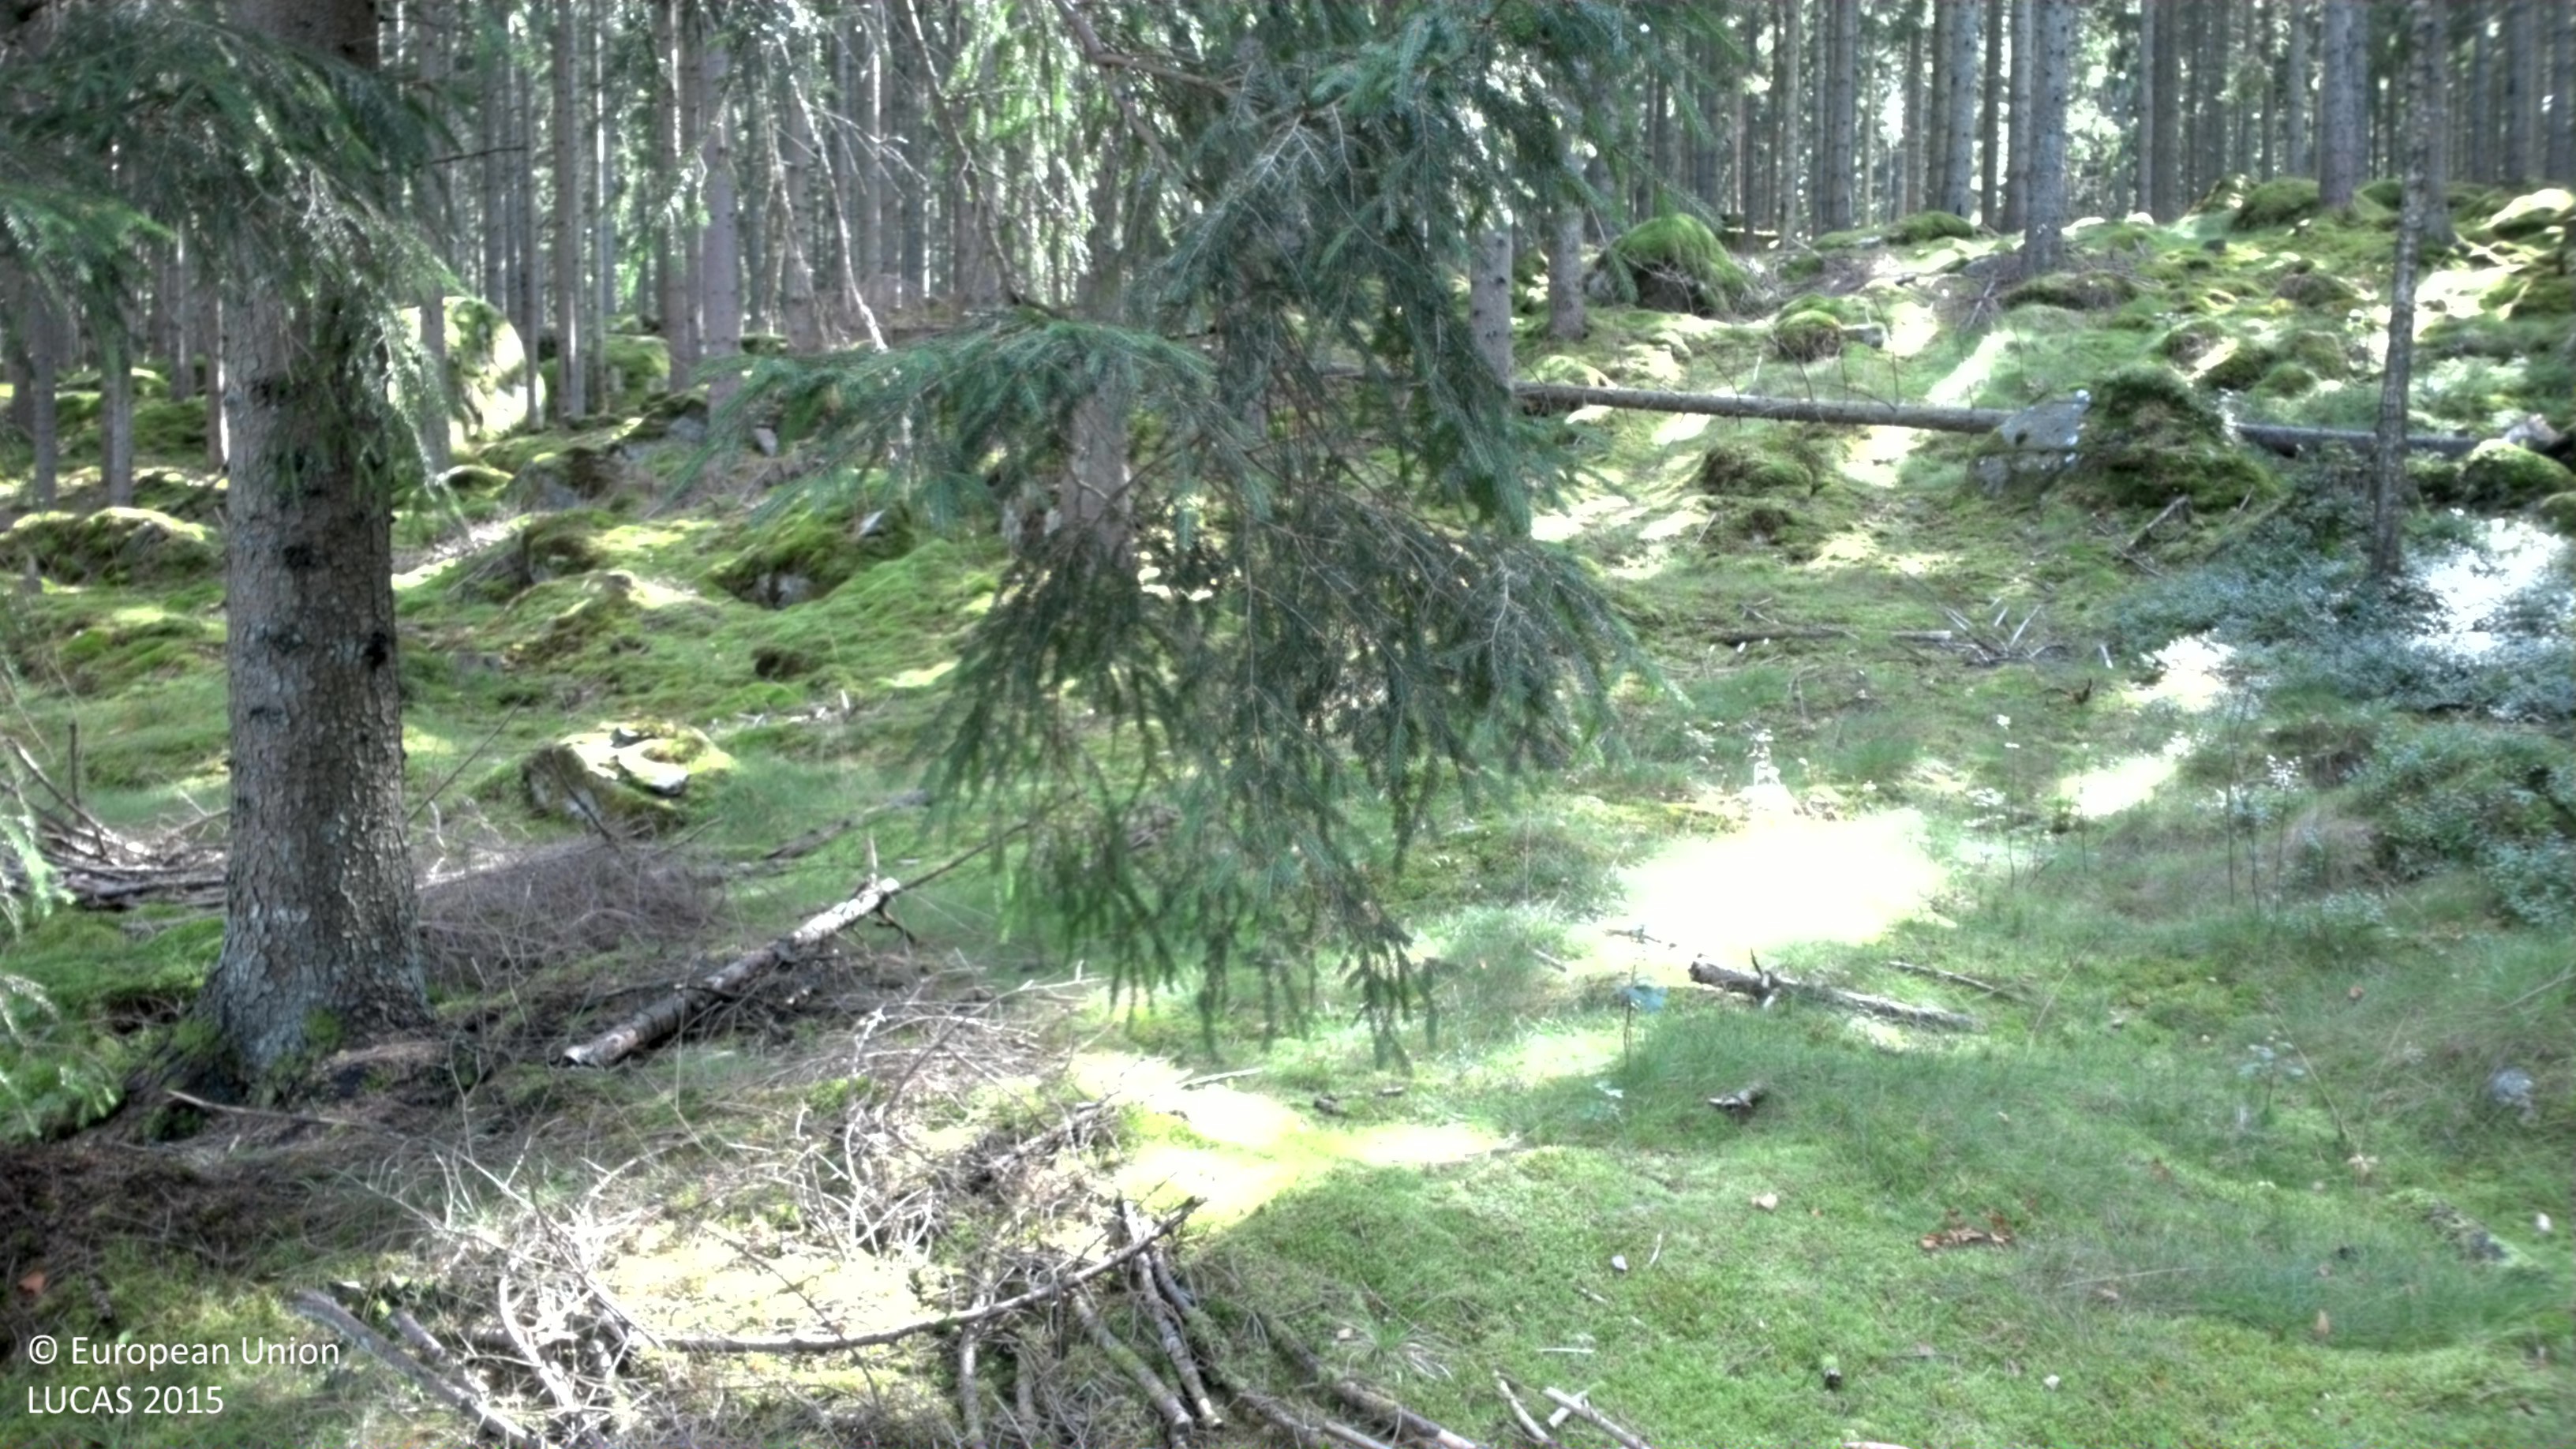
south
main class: Woodland
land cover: Spruce dominated coniferous woodland
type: boreal forest
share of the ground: > 75 %
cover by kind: coniferous forest trees 80 %, lichens and mosses 10 %, shrubs 5 %, herbaceous plants 5 %
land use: Forestry
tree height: > 5 m
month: August
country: SE
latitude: 56.2965
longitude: 14.2797
